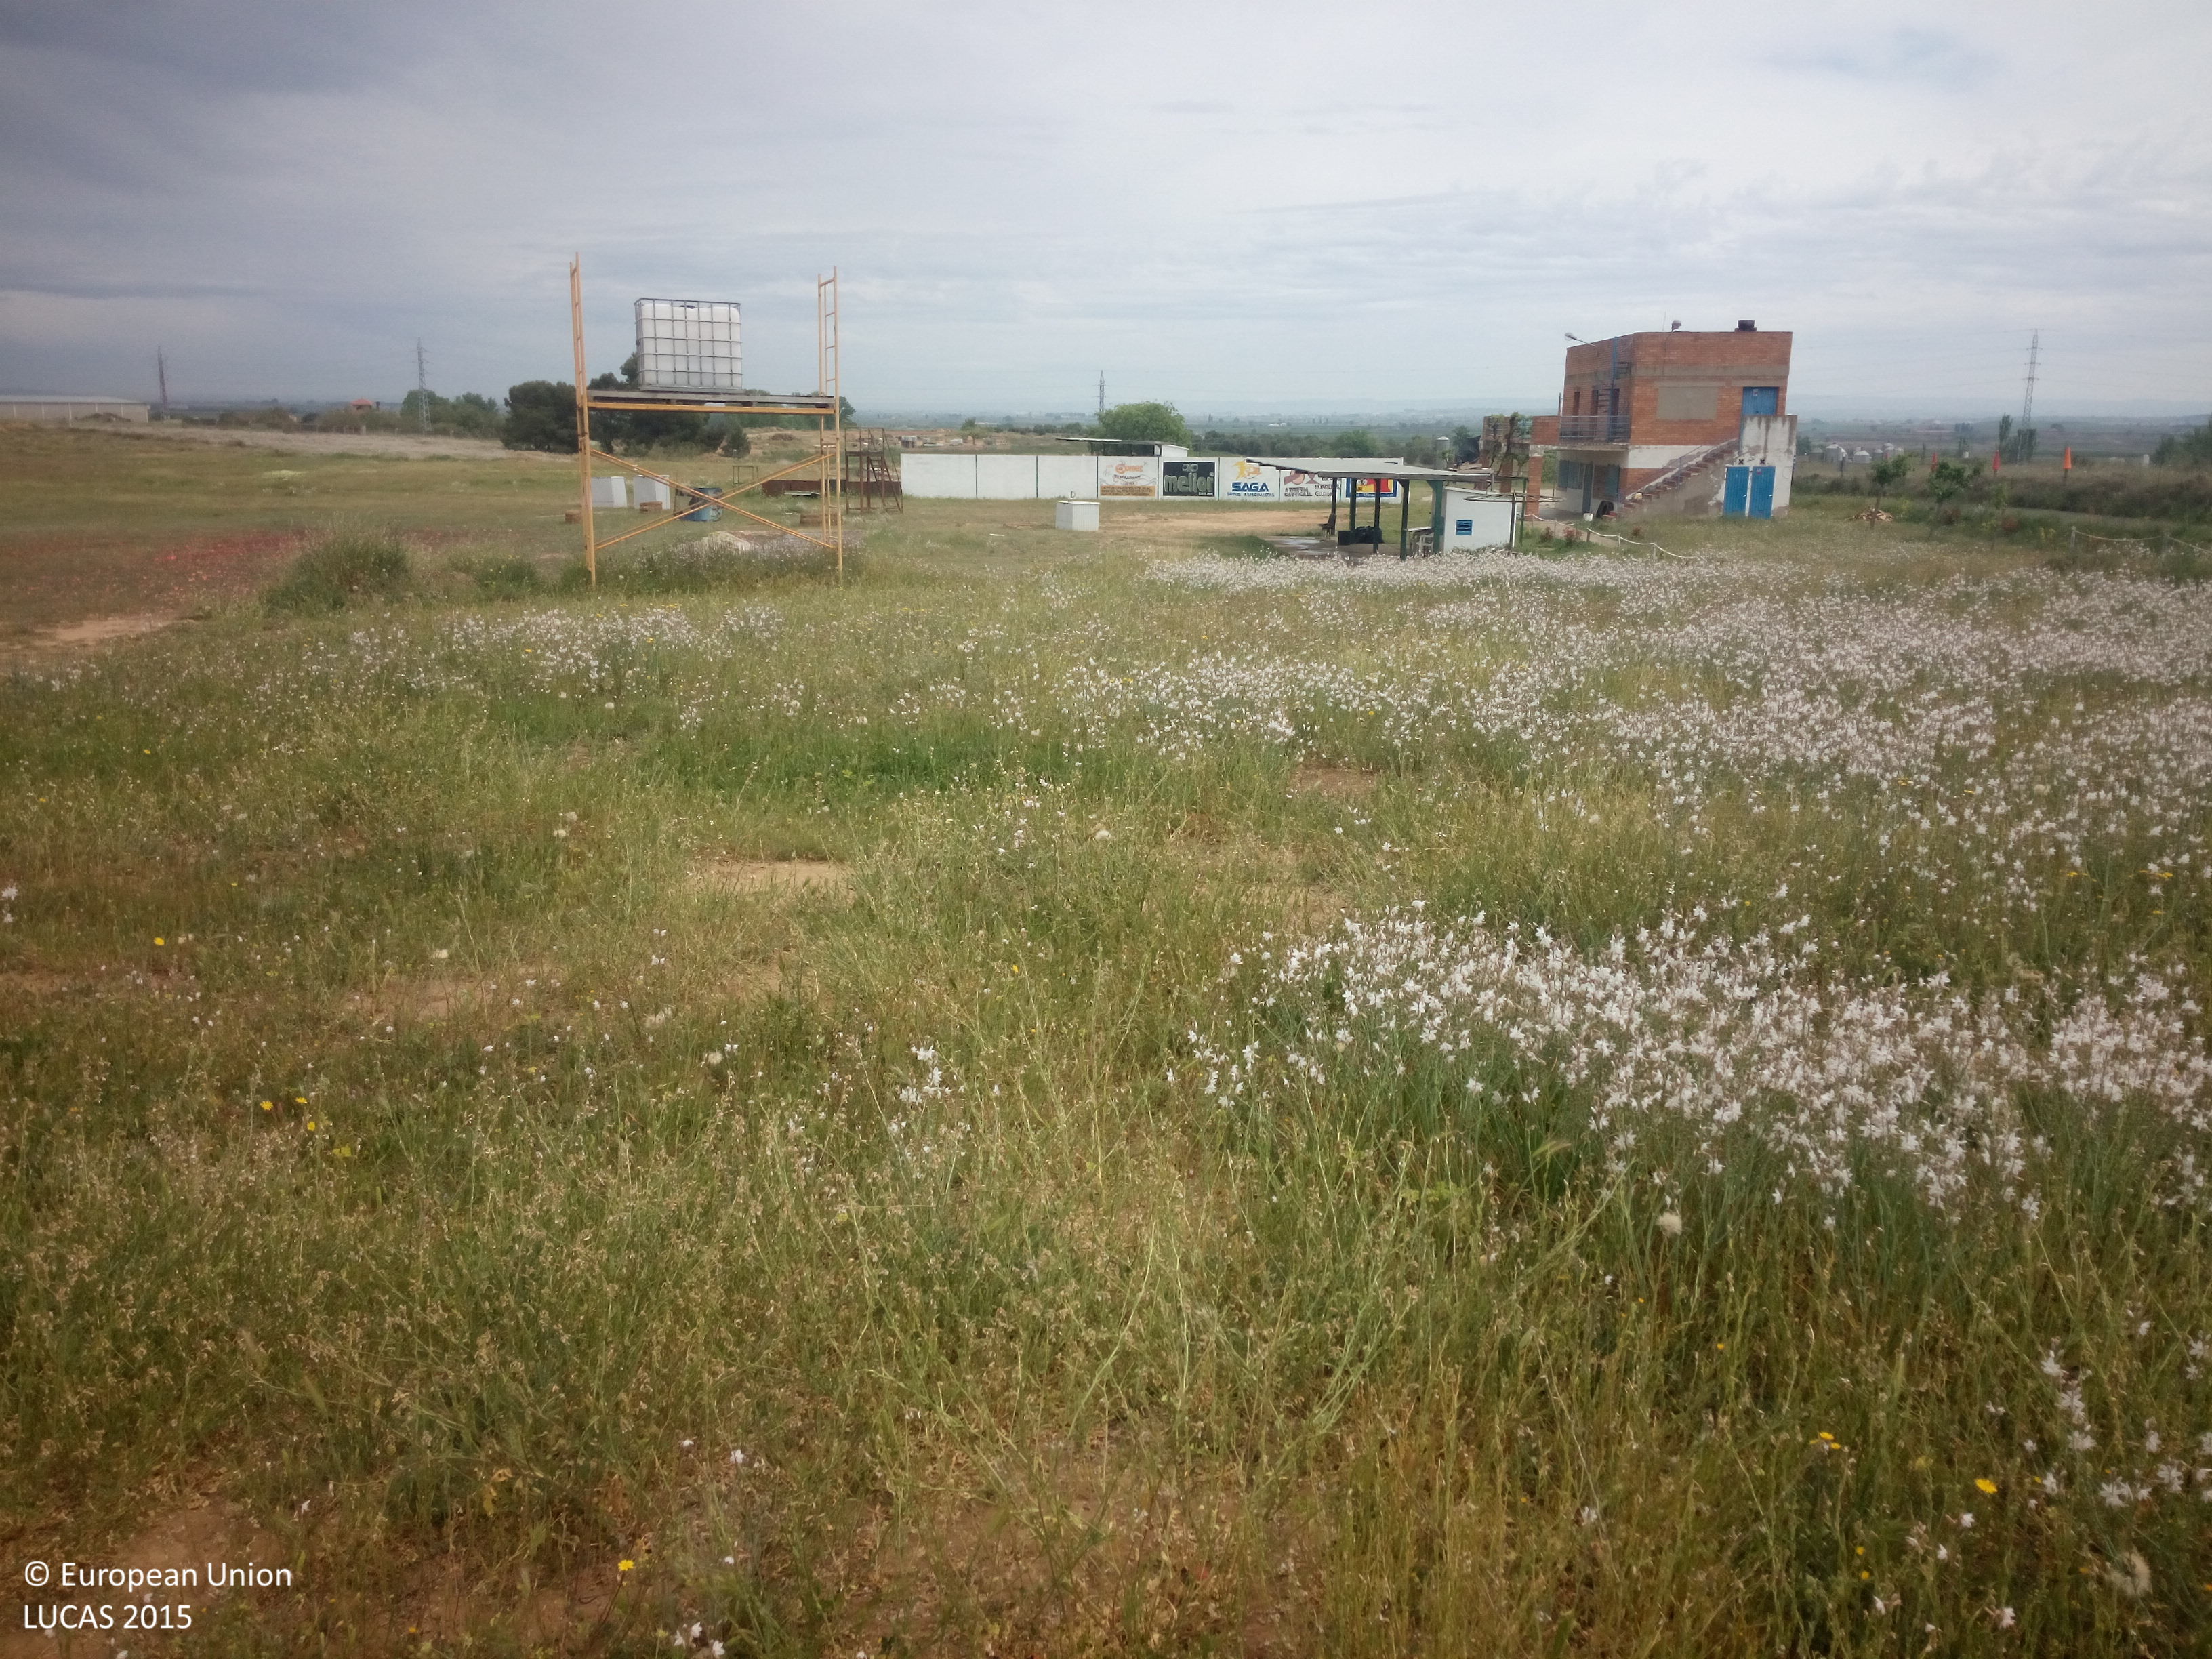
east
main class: Grassland
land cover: Grassland without tree/shrub cover
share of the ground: > 75 %
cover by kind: herbaceous plants 95 %, unconsolidated bare surface 5 %
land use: Semi-natural and natural areas not in use
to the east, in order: Grassland without tree/shrub cover; Artificial constructions in urban areas; Grass margins; Tracks; Grassland with sparse tree/shrub cover; Grassland without tree/shrub cover
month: April
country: ES
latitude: 41.6624
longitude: 0.7043
